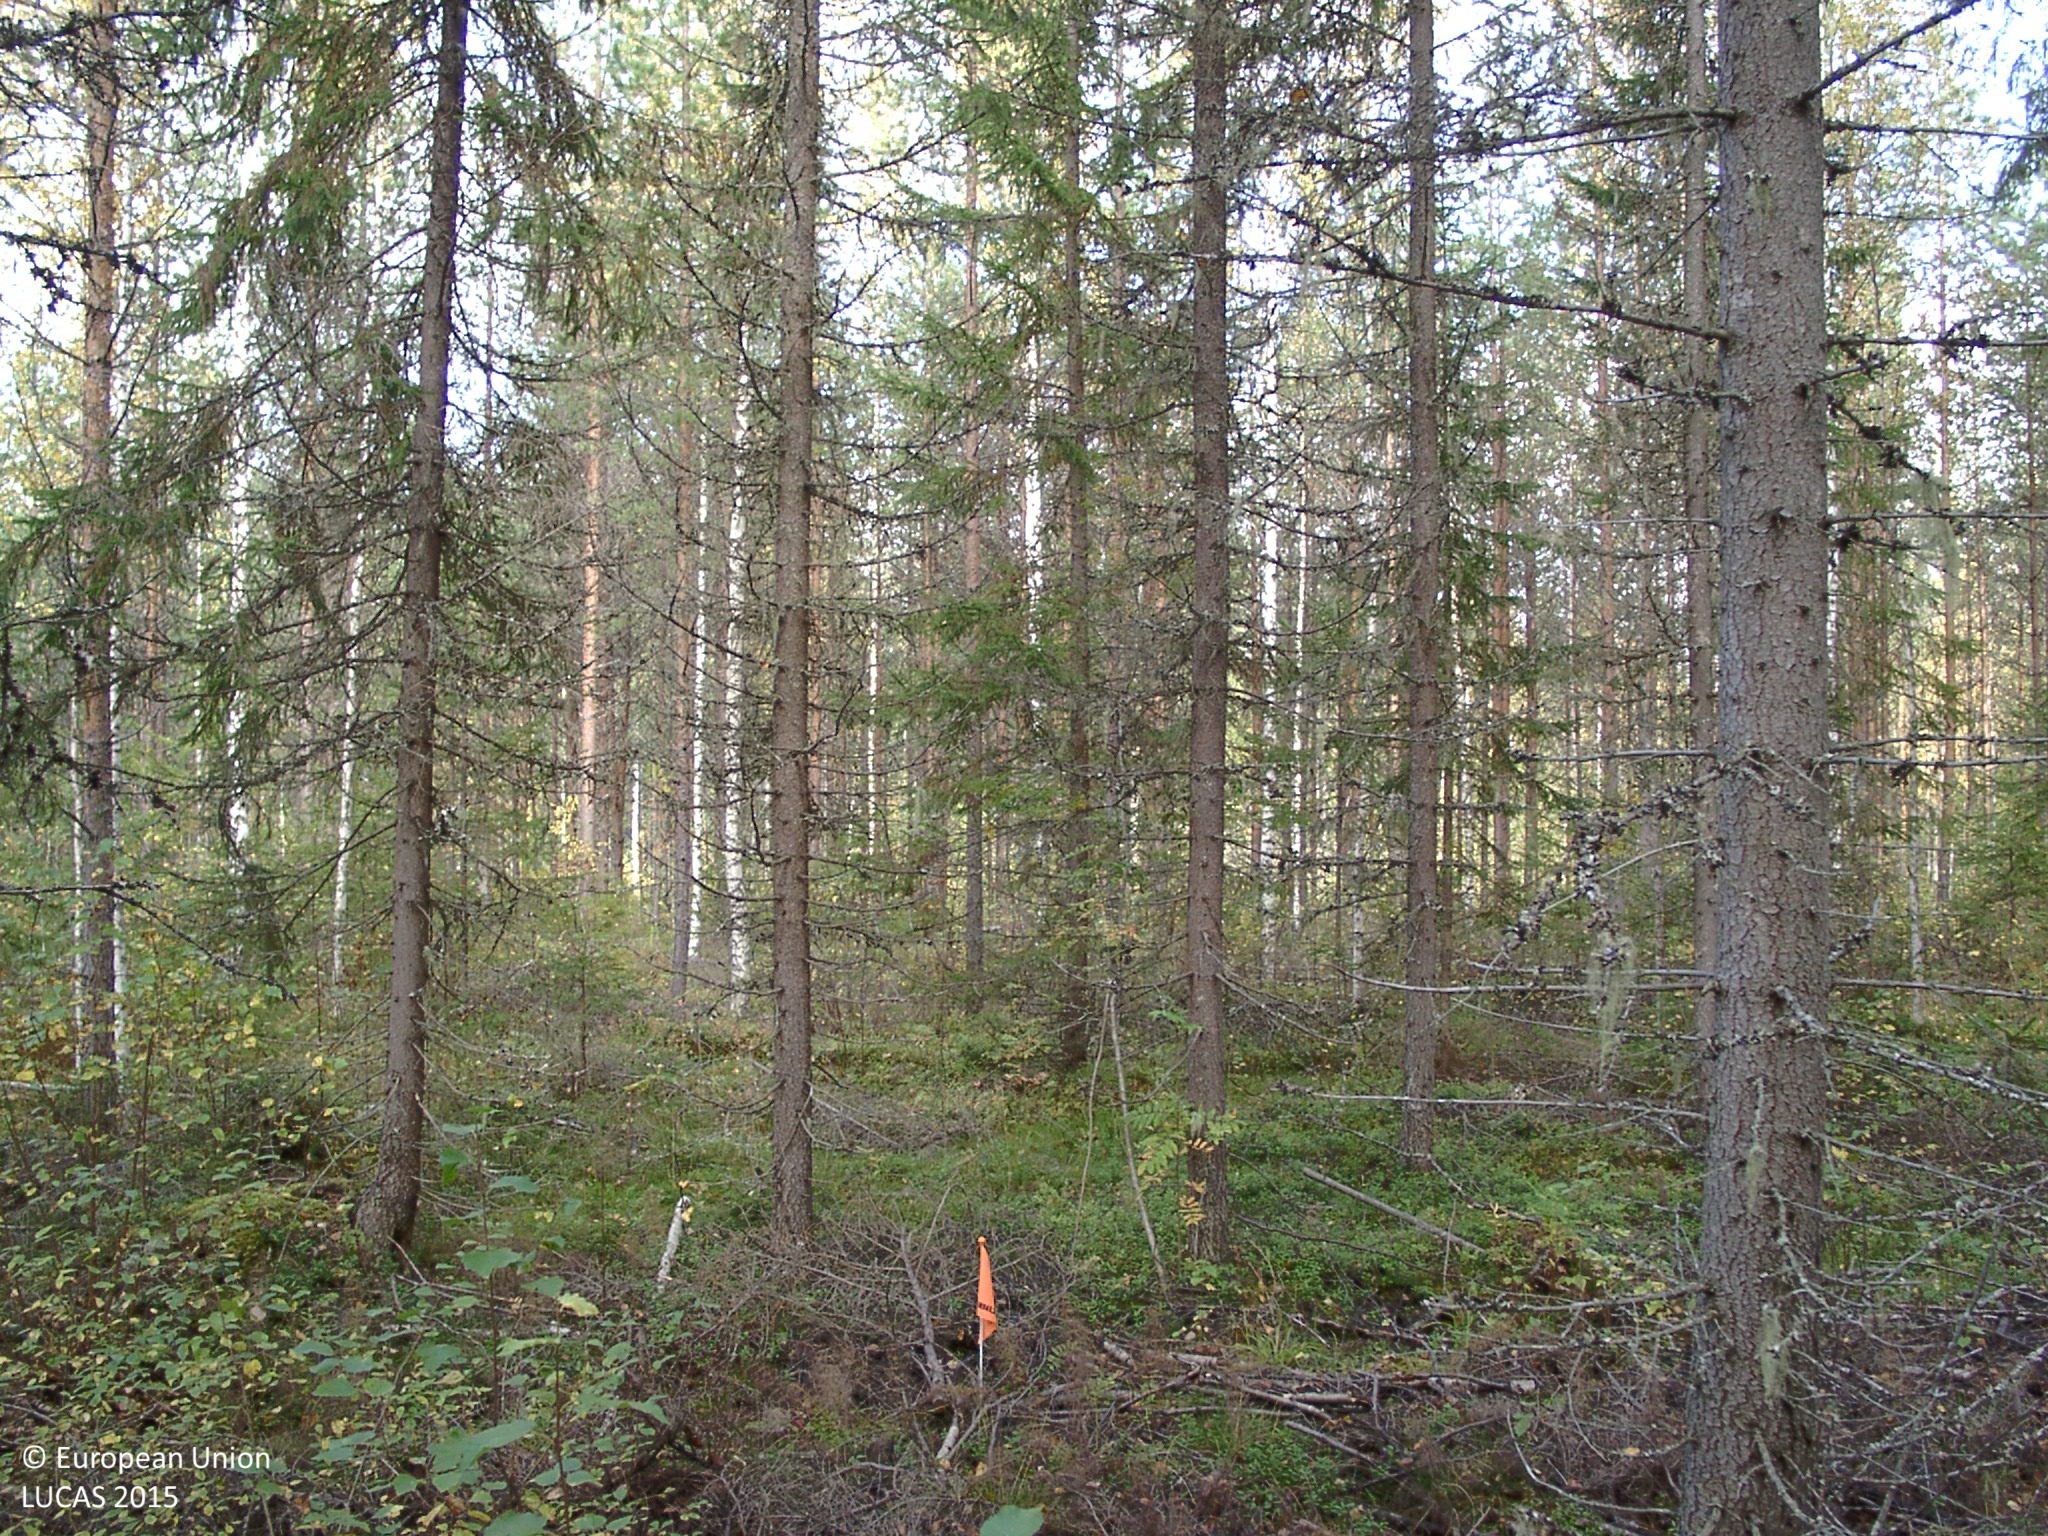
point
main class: Woodland
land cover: Spruce dominated mixed woodland
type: boreal forest
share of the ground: 50 - 75 %
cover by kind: coniferous forest trees 45 %, broadleaved forest trees 15 %, shrubs 15 %, lichens and mosses 10 %, herbaceous plants 5 %
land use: Forestry
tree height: > 5 m
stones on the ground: < 10 %
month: September
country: FI
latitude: 62.6214
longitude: 25.2498
